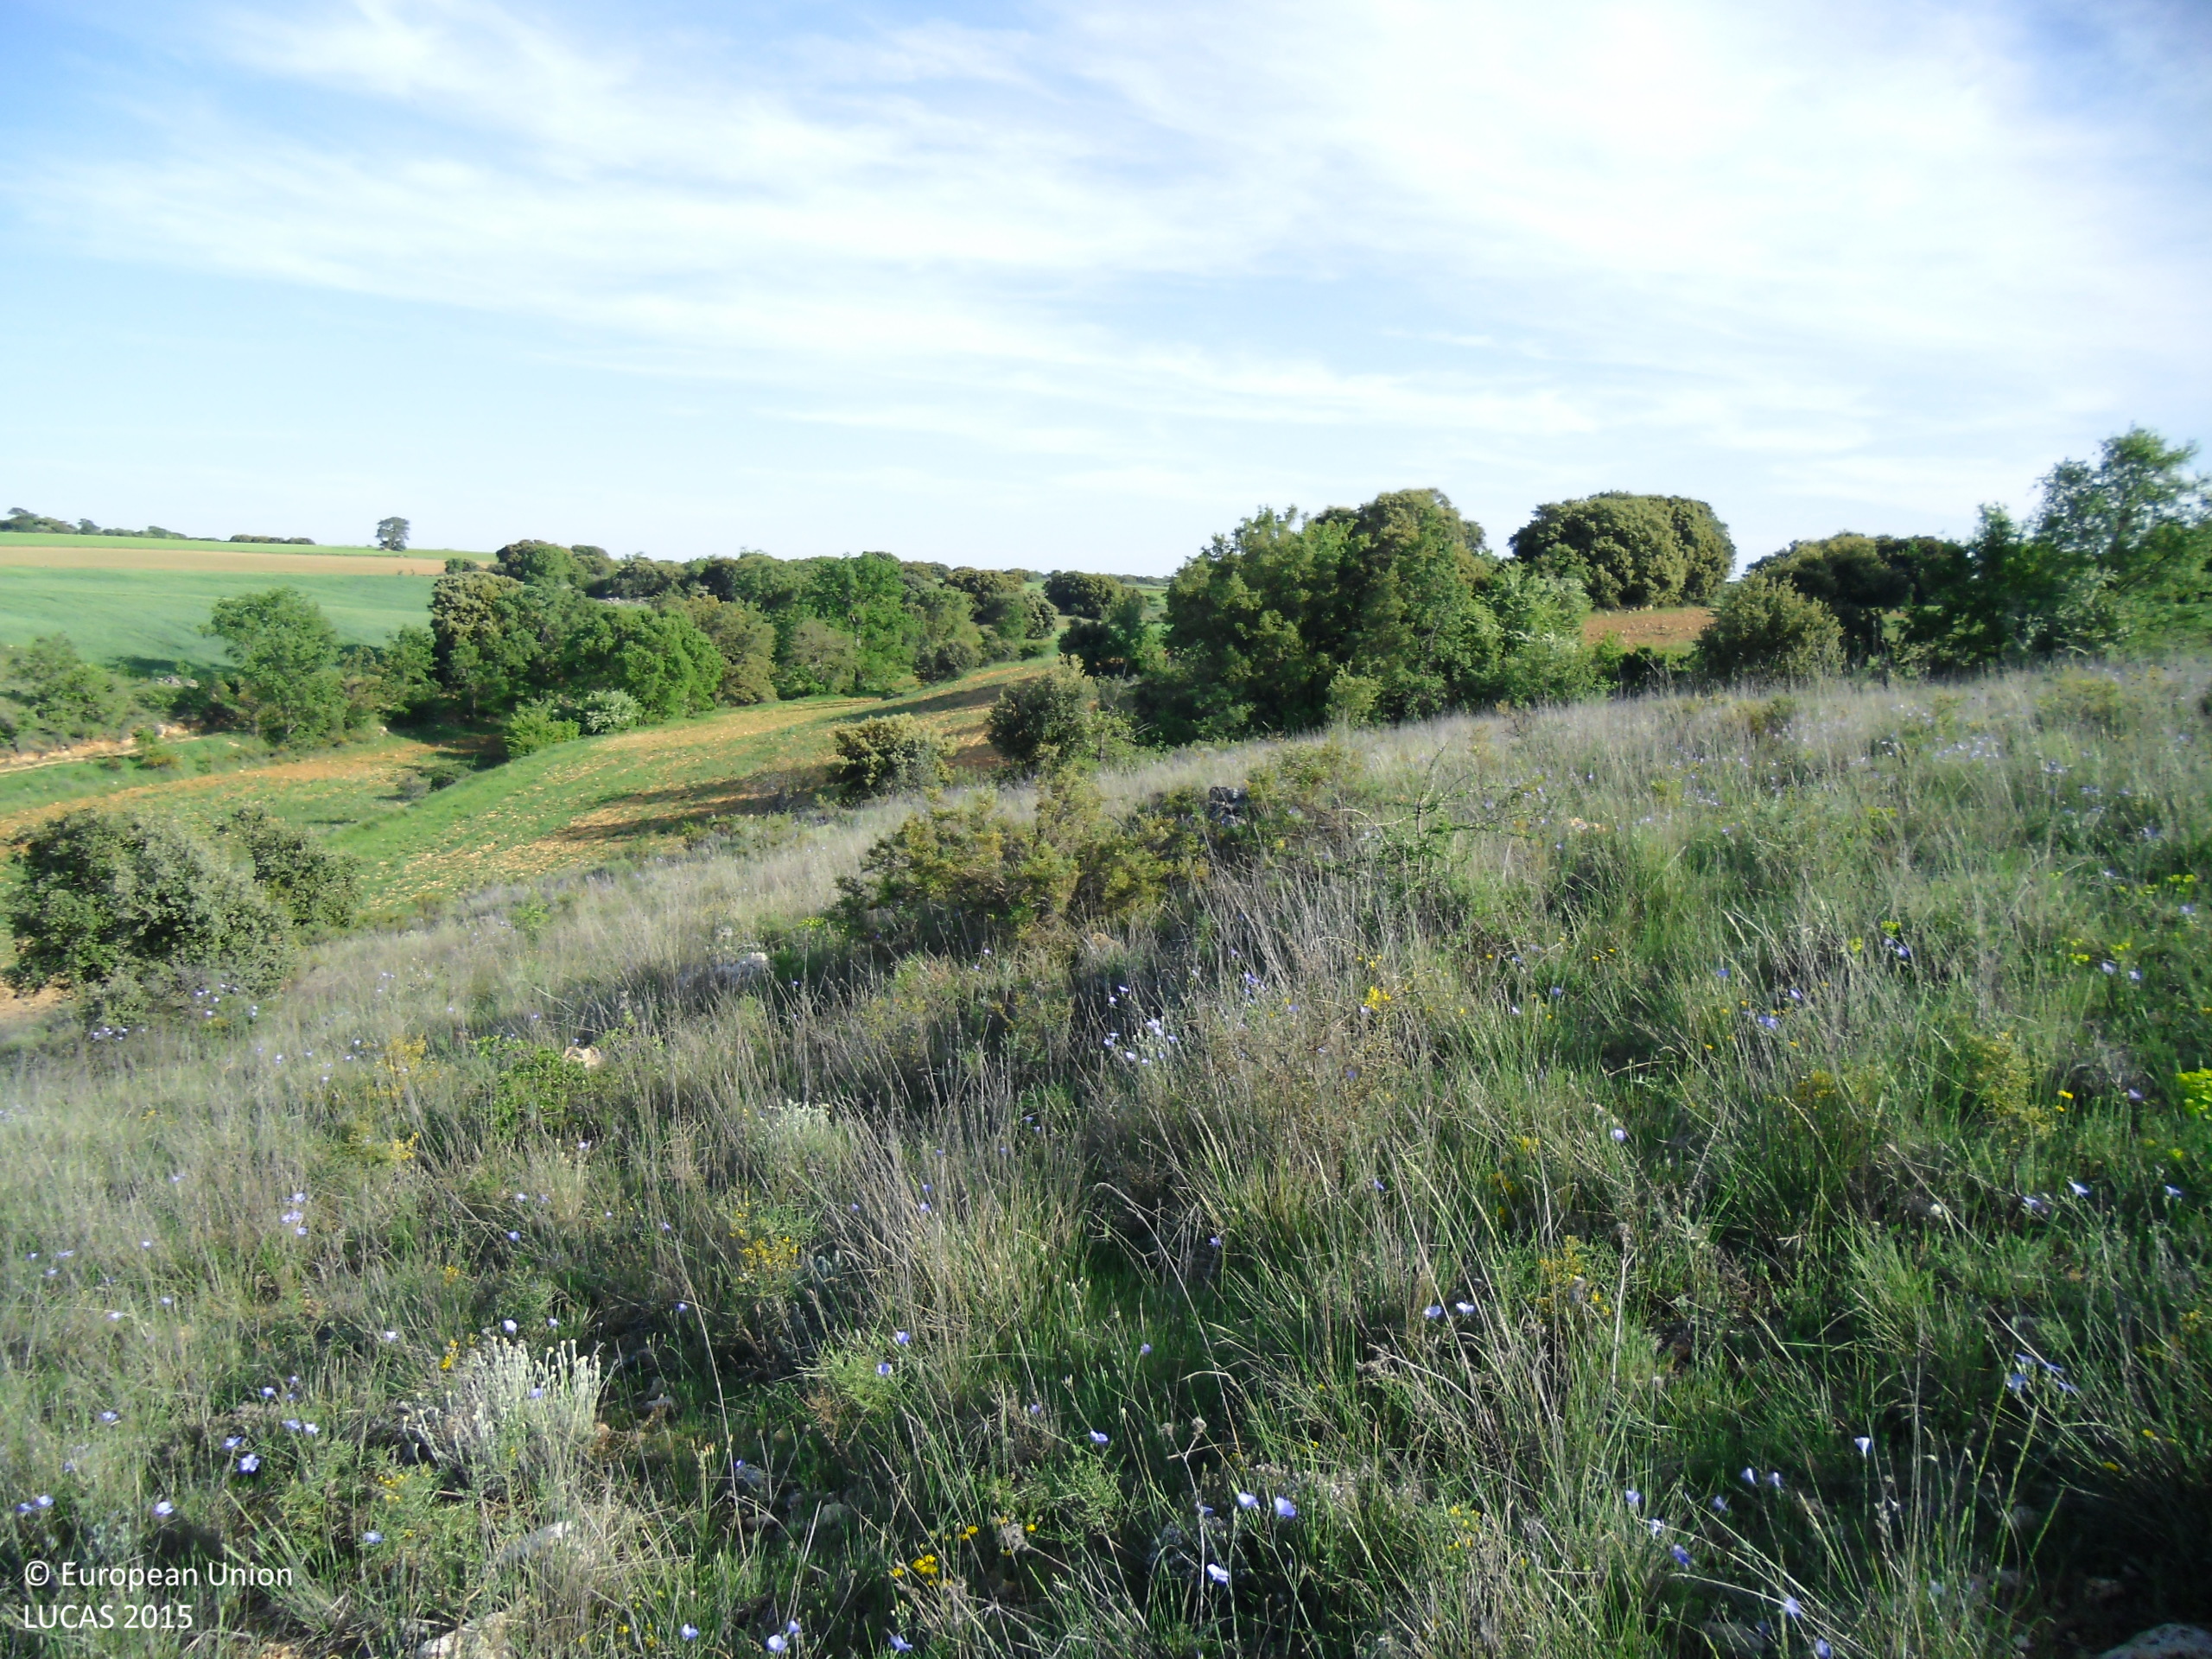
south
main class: Grassland
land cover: Grassland with sparse tree/shrub cover
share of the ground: > 75 %
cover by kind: herbaceous plants 90 %, coniferous forest trees 5 %, shrubs 5 %
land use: Semi-natural and natural areas not in use
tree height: < 5 m
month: May
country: ES
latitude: 40.5236
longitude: -2.9310
